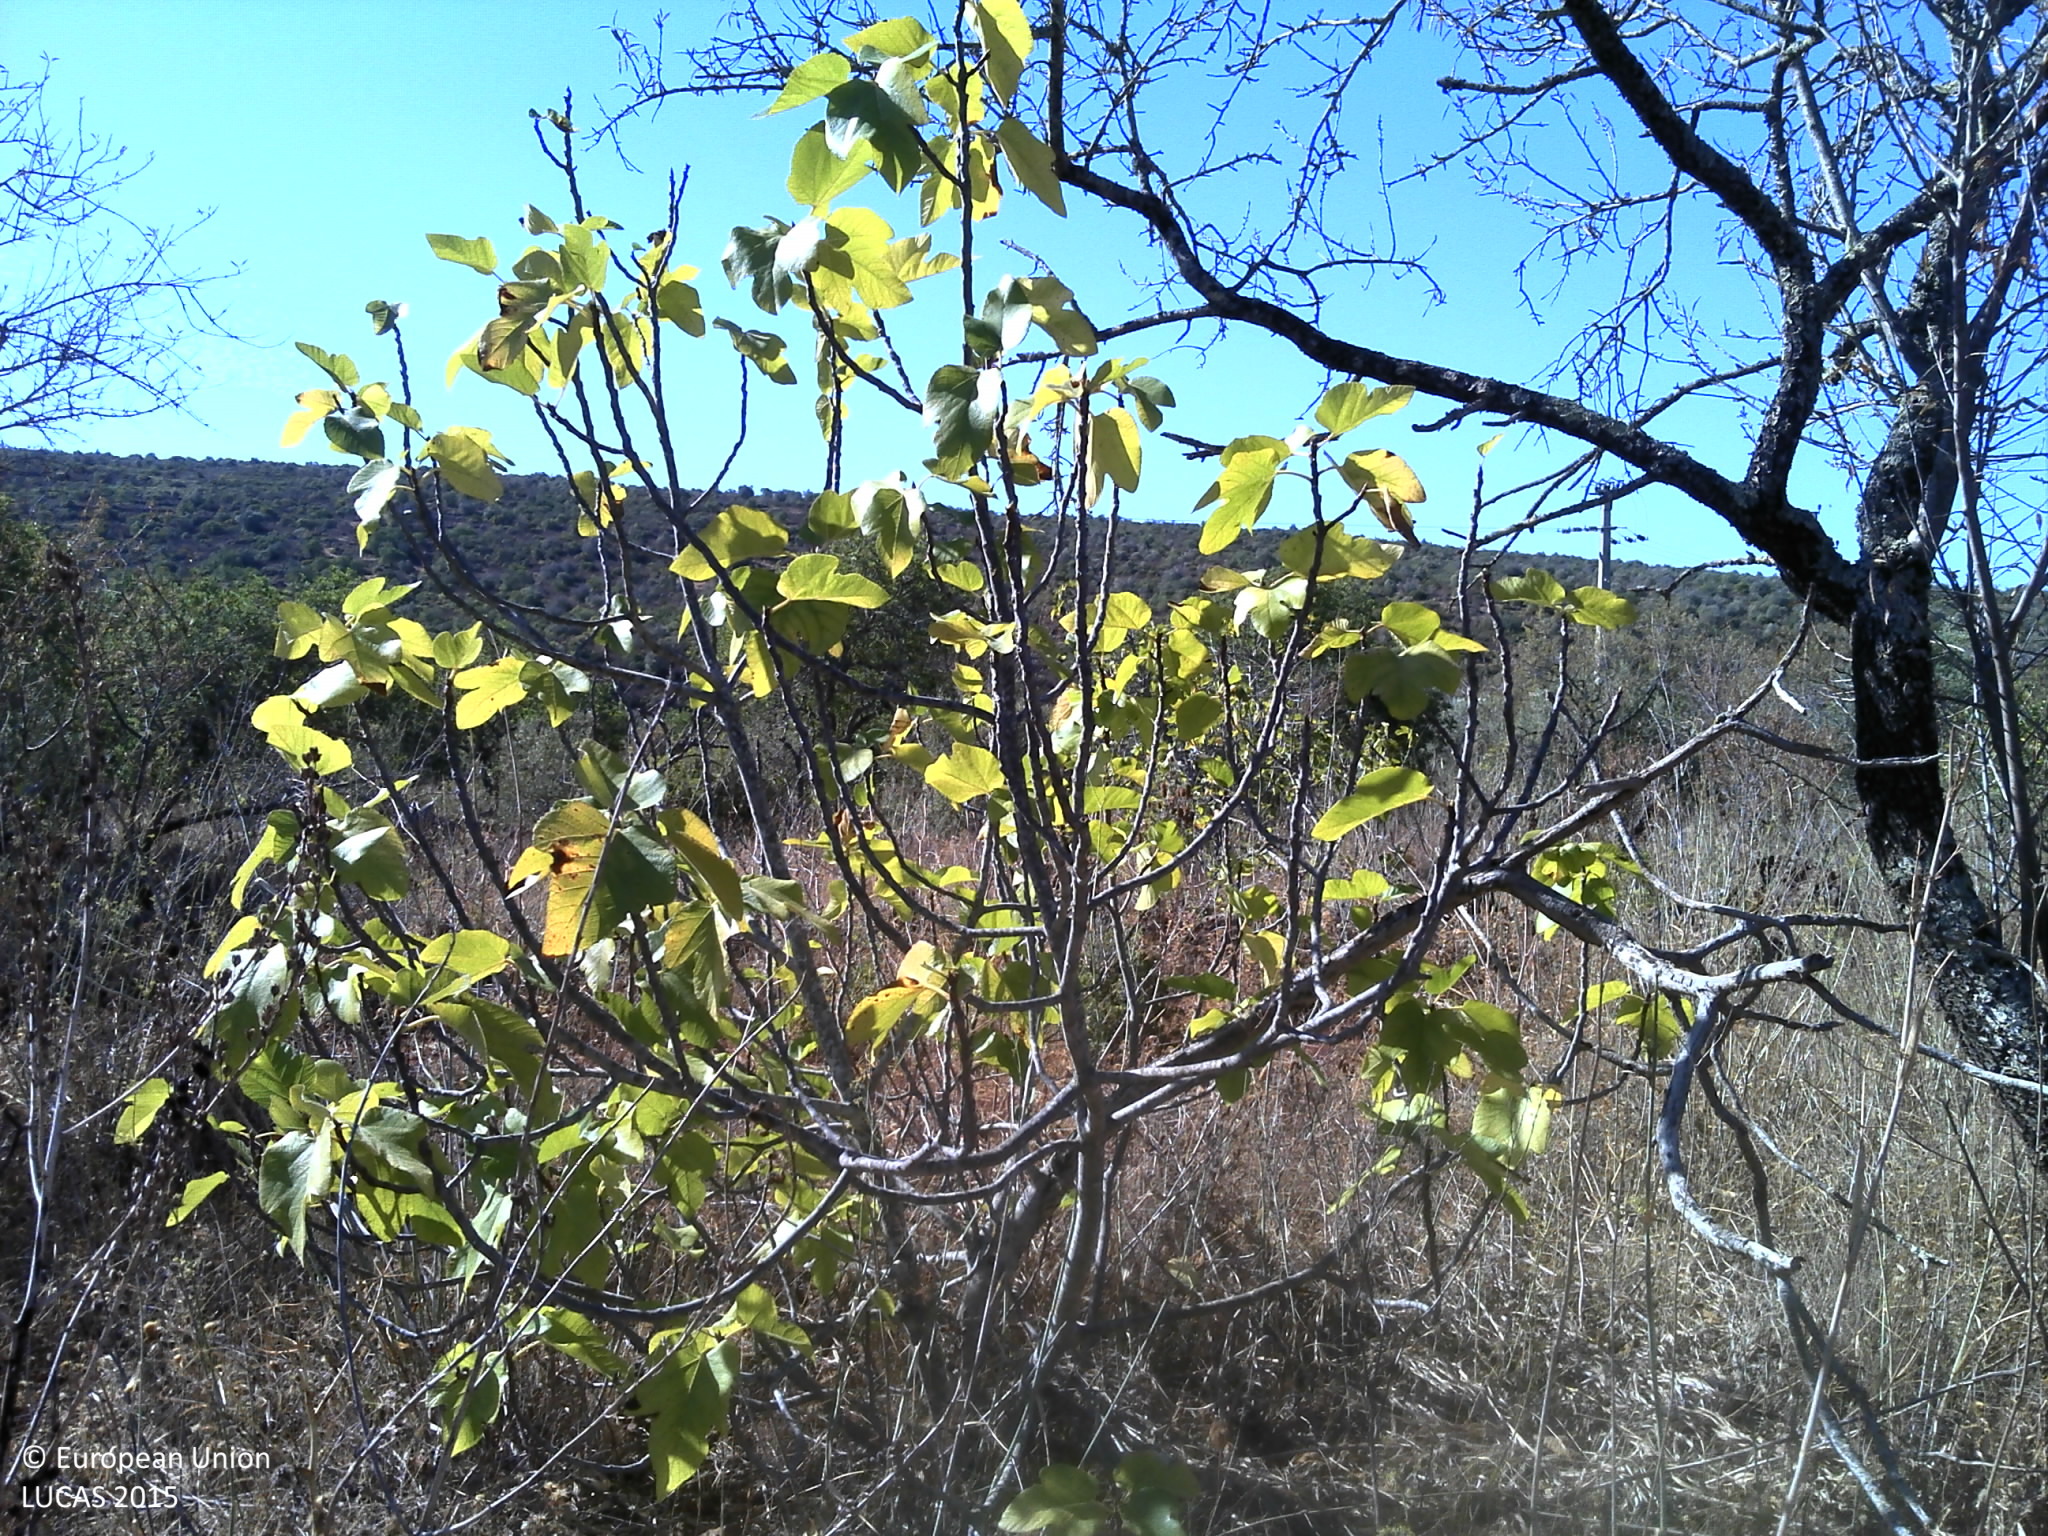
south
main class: Cropland
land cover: Nuts trees
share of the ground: 25 - 50 %
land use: Agriculture (excluding fallow land and kitchen gardens)
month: September
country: PT
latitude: 37.2347
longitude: -8.2008
